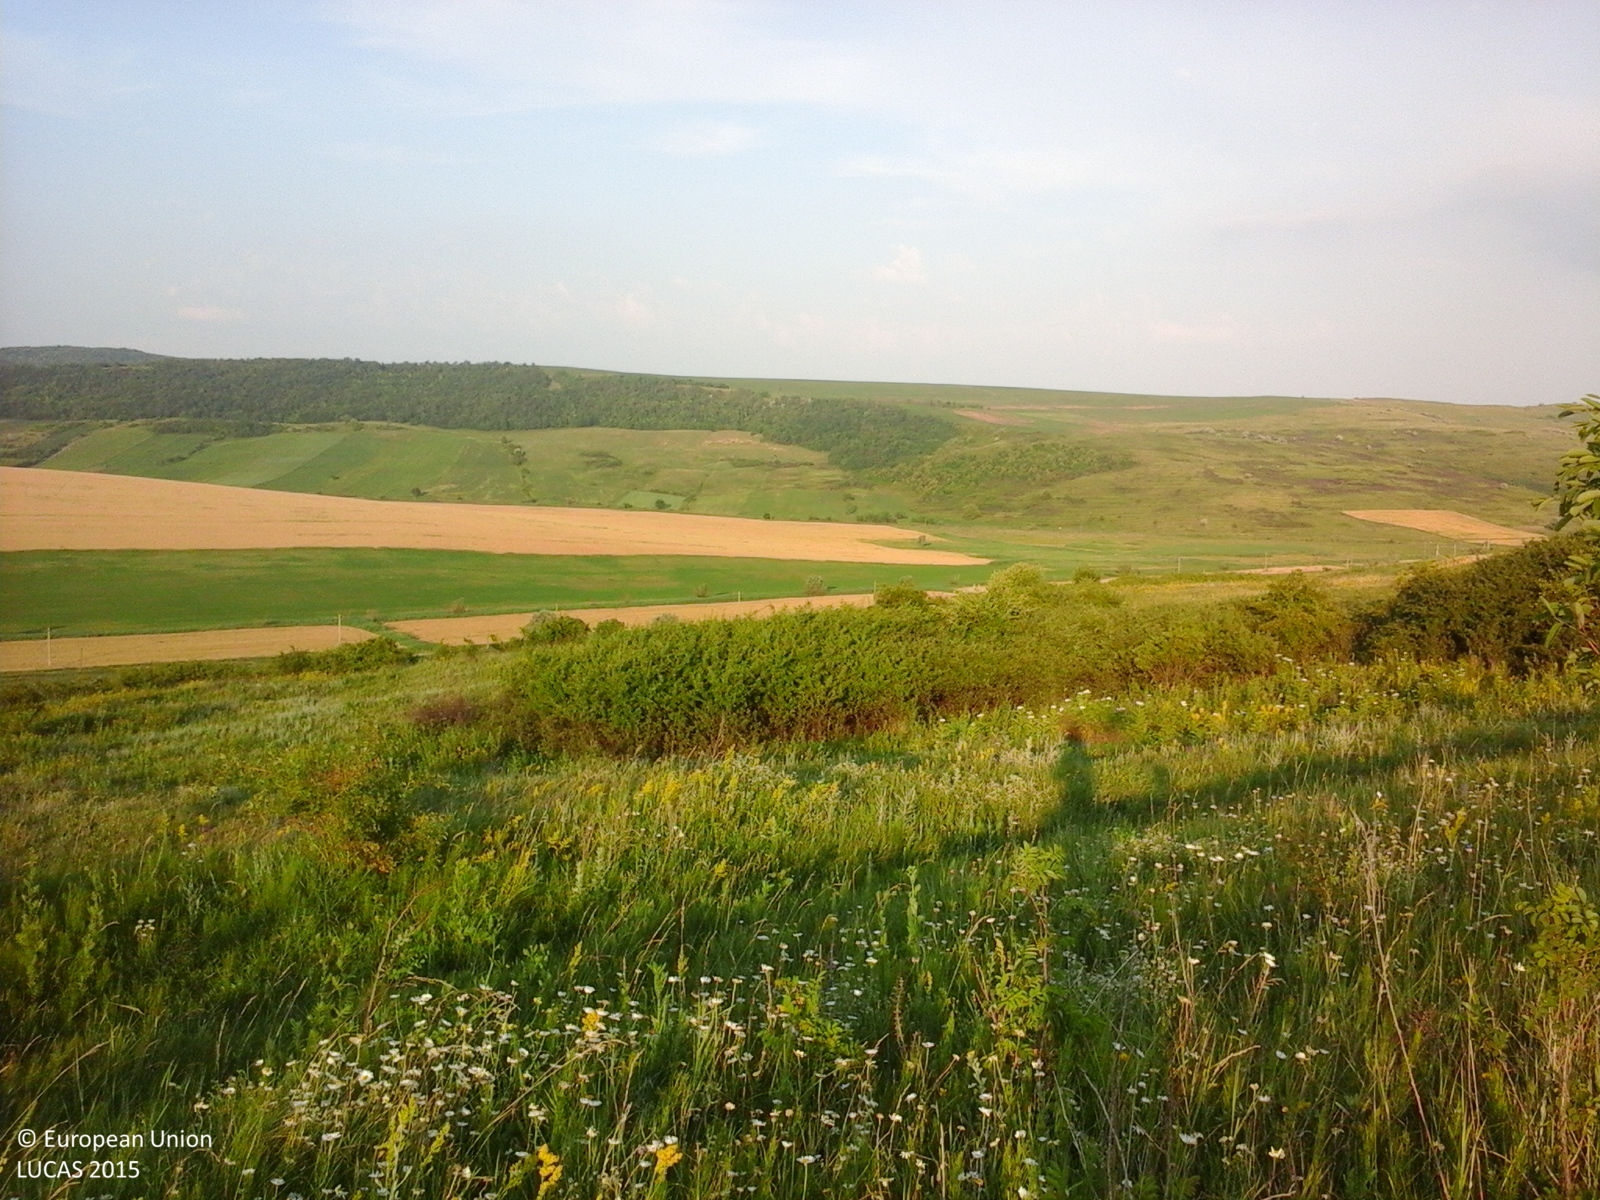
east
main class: Grassland
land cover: Grassland with sparse tree/shrub cover
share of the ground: > 75 %
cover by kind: herbaceous plants 90 %, broadleaved forest trees 5 %, shrubs 5 %
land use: Agriculture (excluding fallow land and kitchen gardens)
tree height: < 5 m
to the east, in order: Grassland with sparse tree/shrub cover; Tracks; Grassland with sparse tree/shrub cover; Shrubland without tree cover; Grassland with sparse tree/shrub cover; Shrubland without tree cover; Grassland without tree/shrub cover; Lucerne
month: June
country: RO
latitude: 46.6690
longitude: 27.4556
